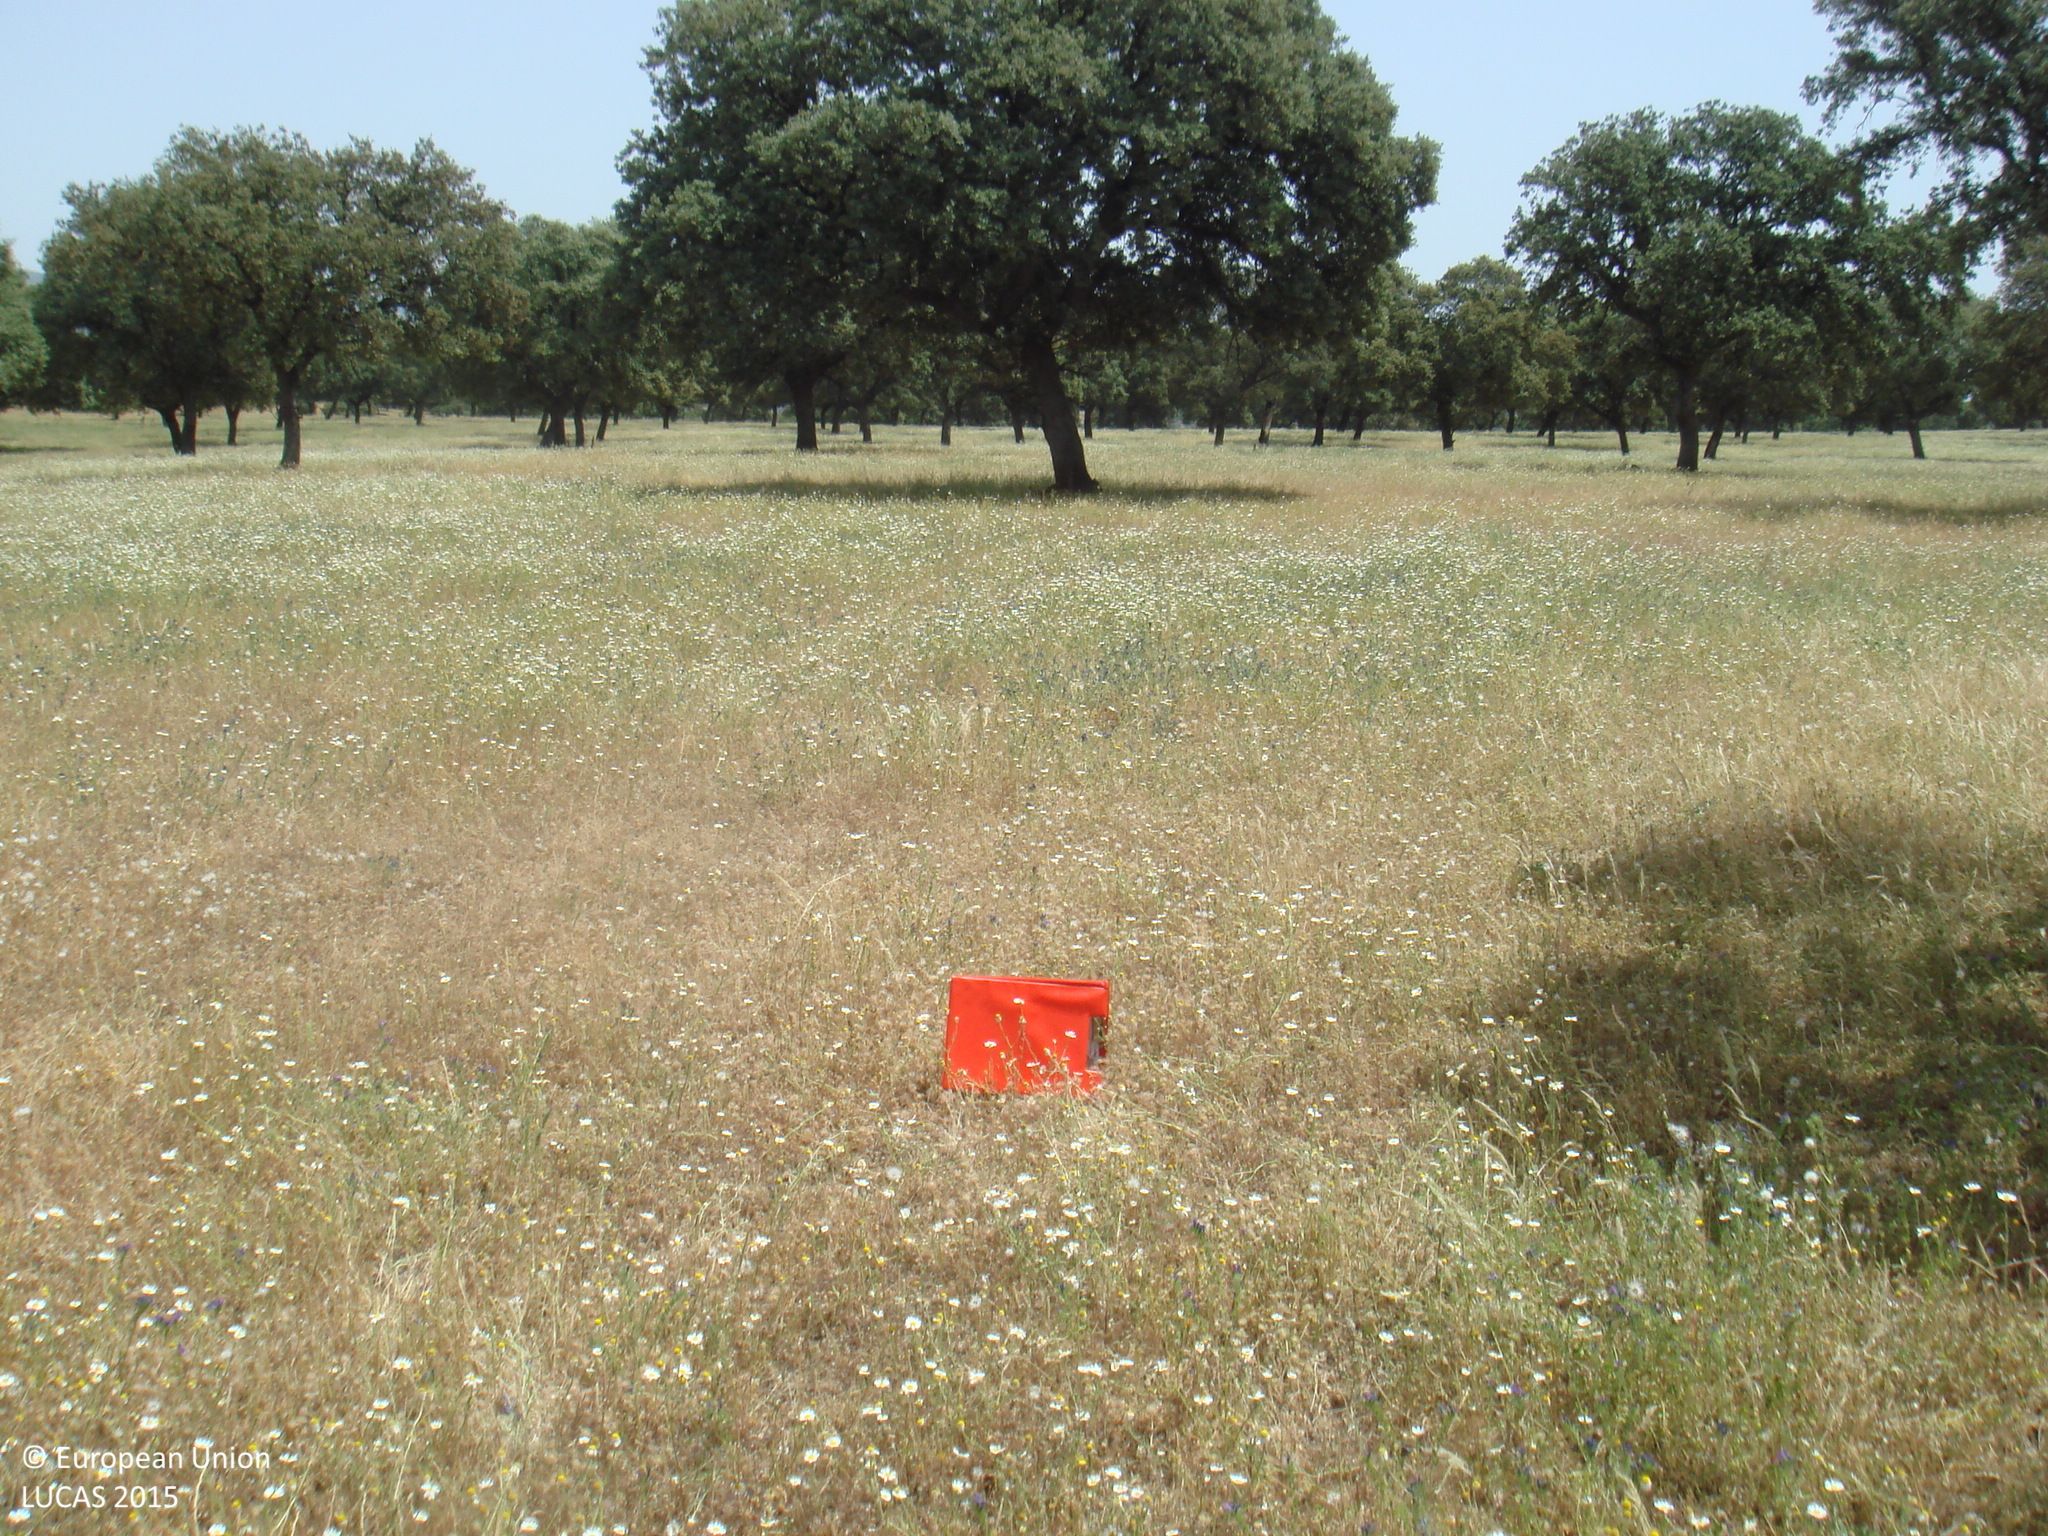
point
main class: Woodland
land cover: Broadleaved woodland
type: broadleaved evergreen forest
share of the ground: 25 - 50 %
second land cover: Grassland without tree/shrub cover
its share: > 75 %
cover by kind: herbaceous plants 70 %, broadleaved forest trees 30 %
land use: Forestry
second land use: Agriculture (excluding fallow land and kitchen gardens)
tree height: > 5 m
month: May
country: ES
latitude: 38.5439
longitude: -4.7217
